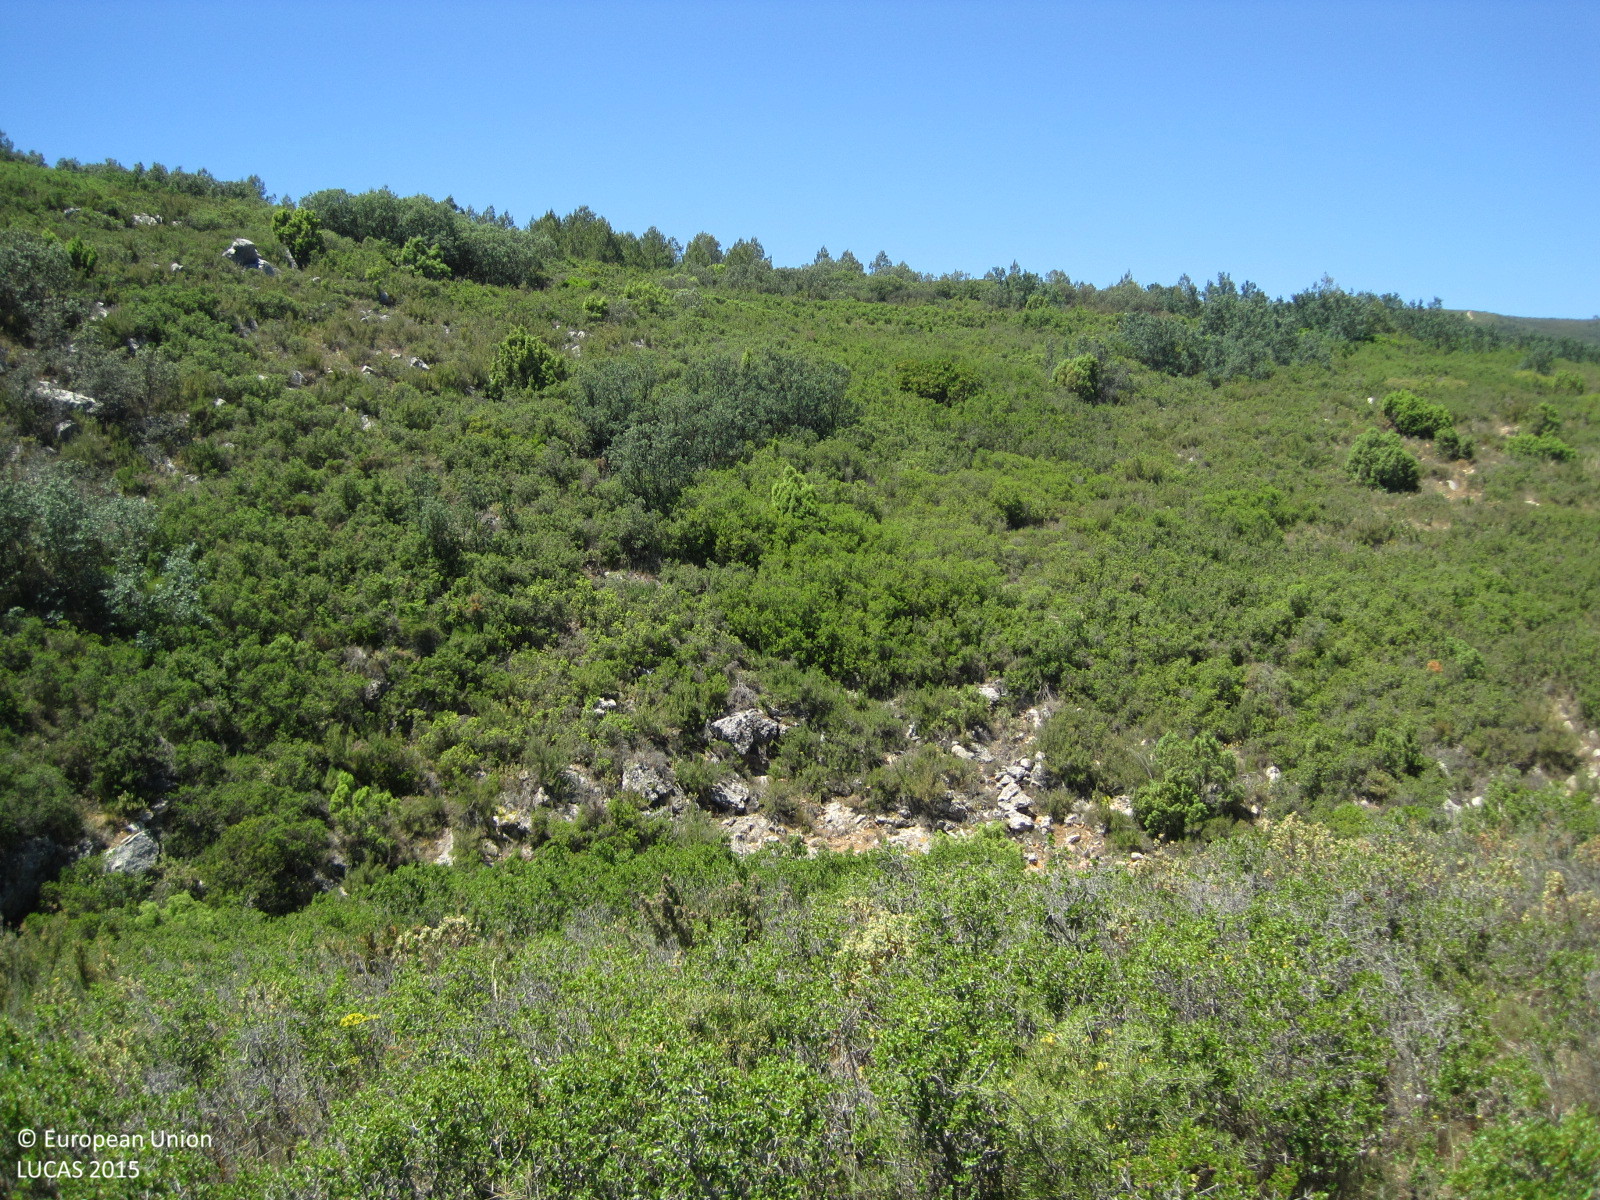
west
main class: Shrubland
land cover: Shrubland without tree cover
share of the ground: > 75 %
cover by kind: shrubs 95 %, consolidated bare surface 5 %
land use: Semi-natural and natural areas not in use
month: May
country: ES
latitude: 39.4254
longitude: -0.8607
